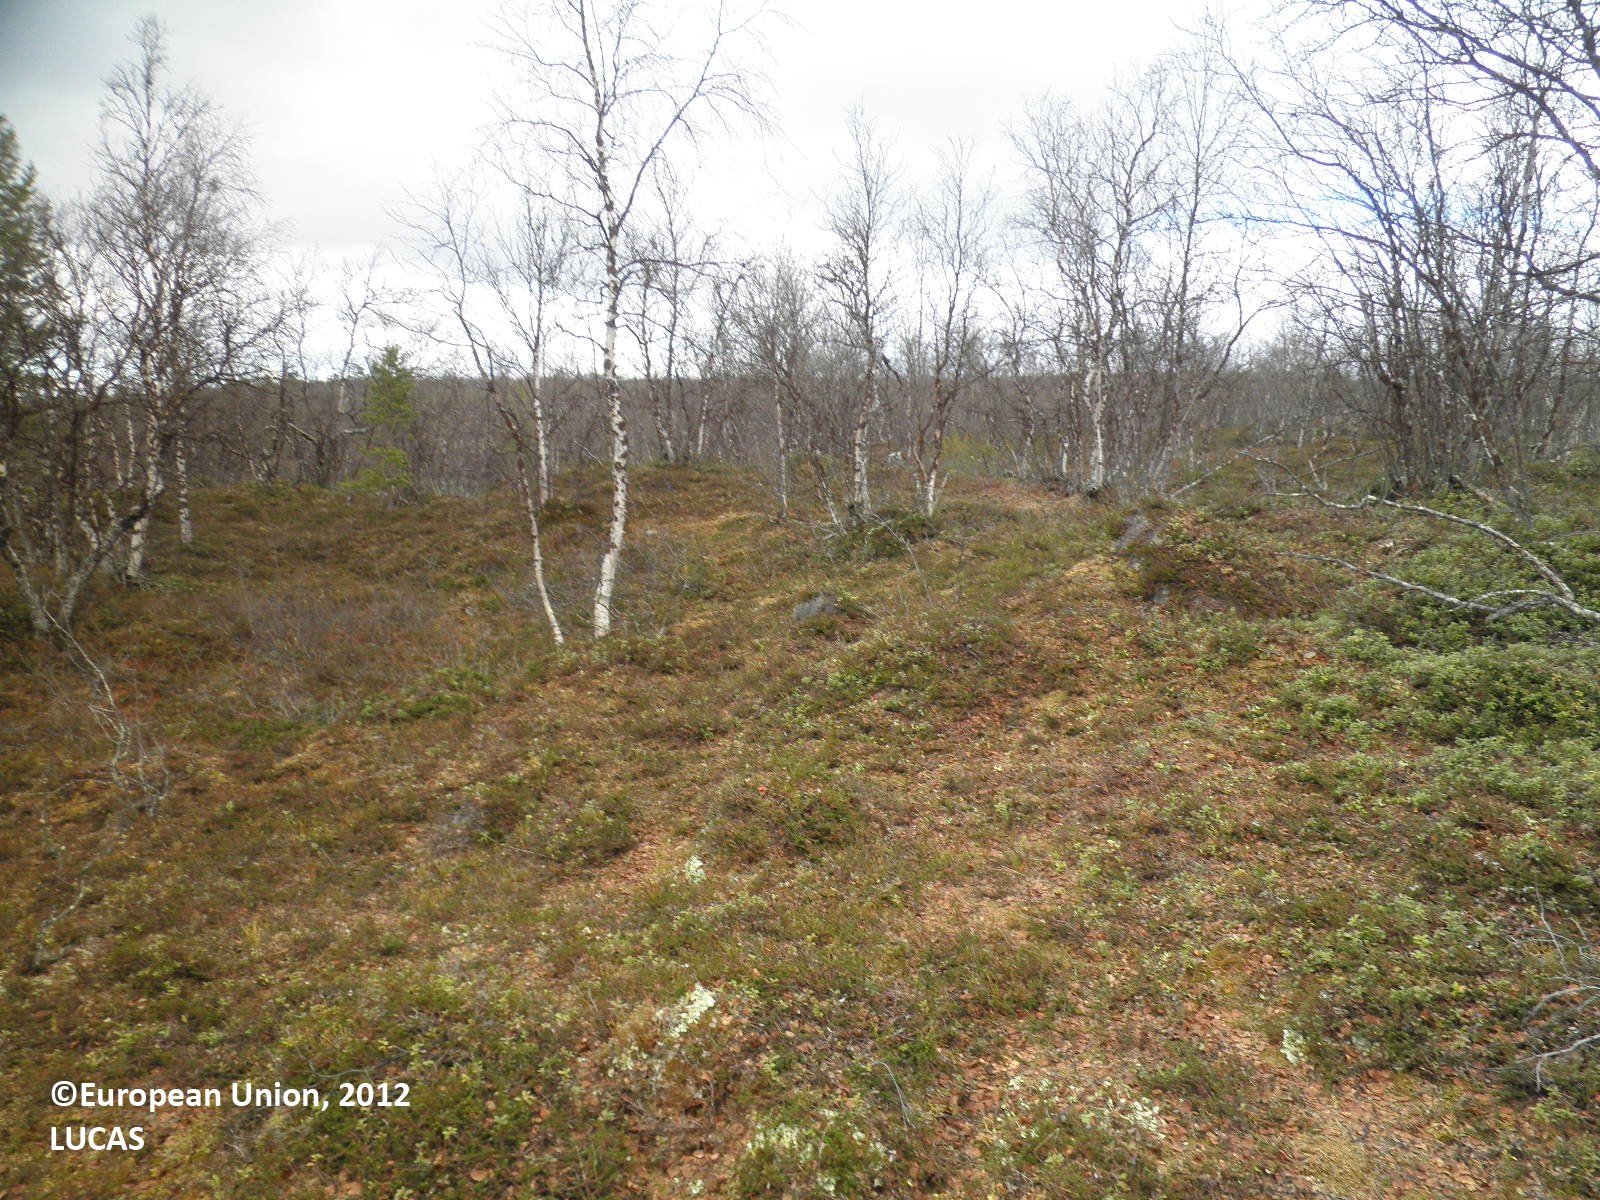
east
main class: Woodland
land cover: Broadleaved woodland
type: boreal forest
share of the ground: 50 - 75 %
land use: Forestry
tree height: > 5 m
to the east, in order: Broadleaved woodland; Ditches and canals; Broadleaved woodland; Ditches and canals; Shrubland with sparse tree cover
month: May
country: FI
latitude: 69.1819
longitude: 26.9192
